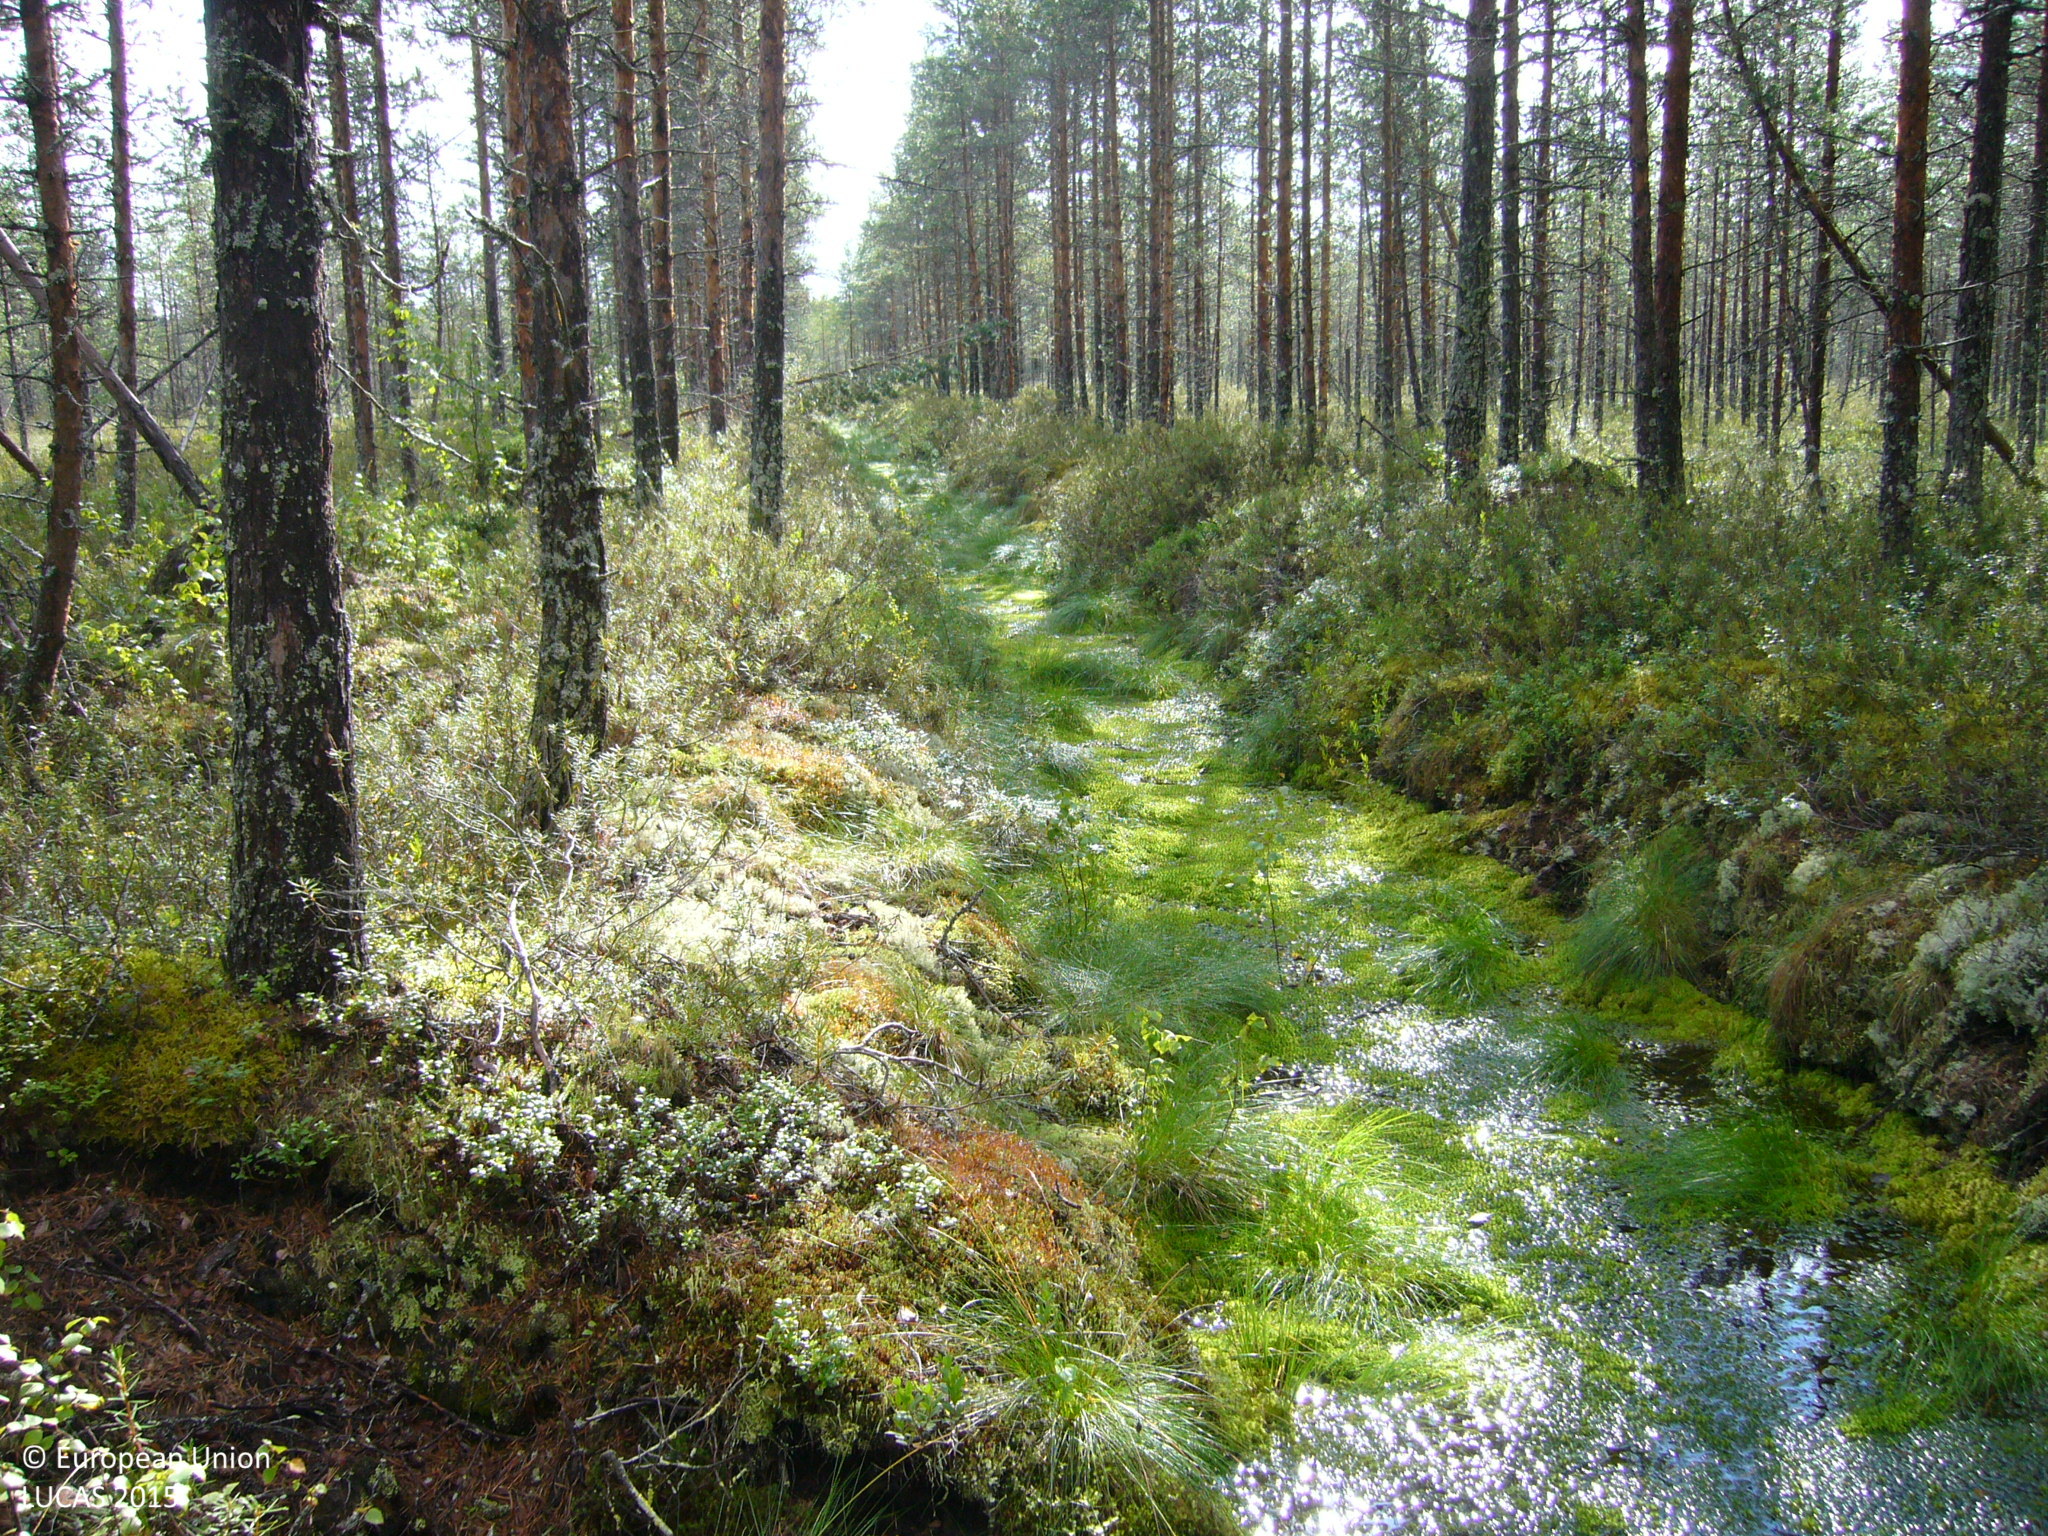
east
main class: Woodland
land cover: Pine dominated coniferous woodland
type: boreal forest
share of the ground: 25 - 50 %
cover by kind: shrubs 70 %, coniferous forest trees 30 %
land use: Forestry
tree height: > 5 m
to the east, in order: Pine dominated coniferous woodland; Ditches and canals; Pine dominated coniferous woodland; Ditches and canals; Pine dominated coniferous woodland
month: July
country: FI
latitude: 64.0021
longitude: 26.3730
